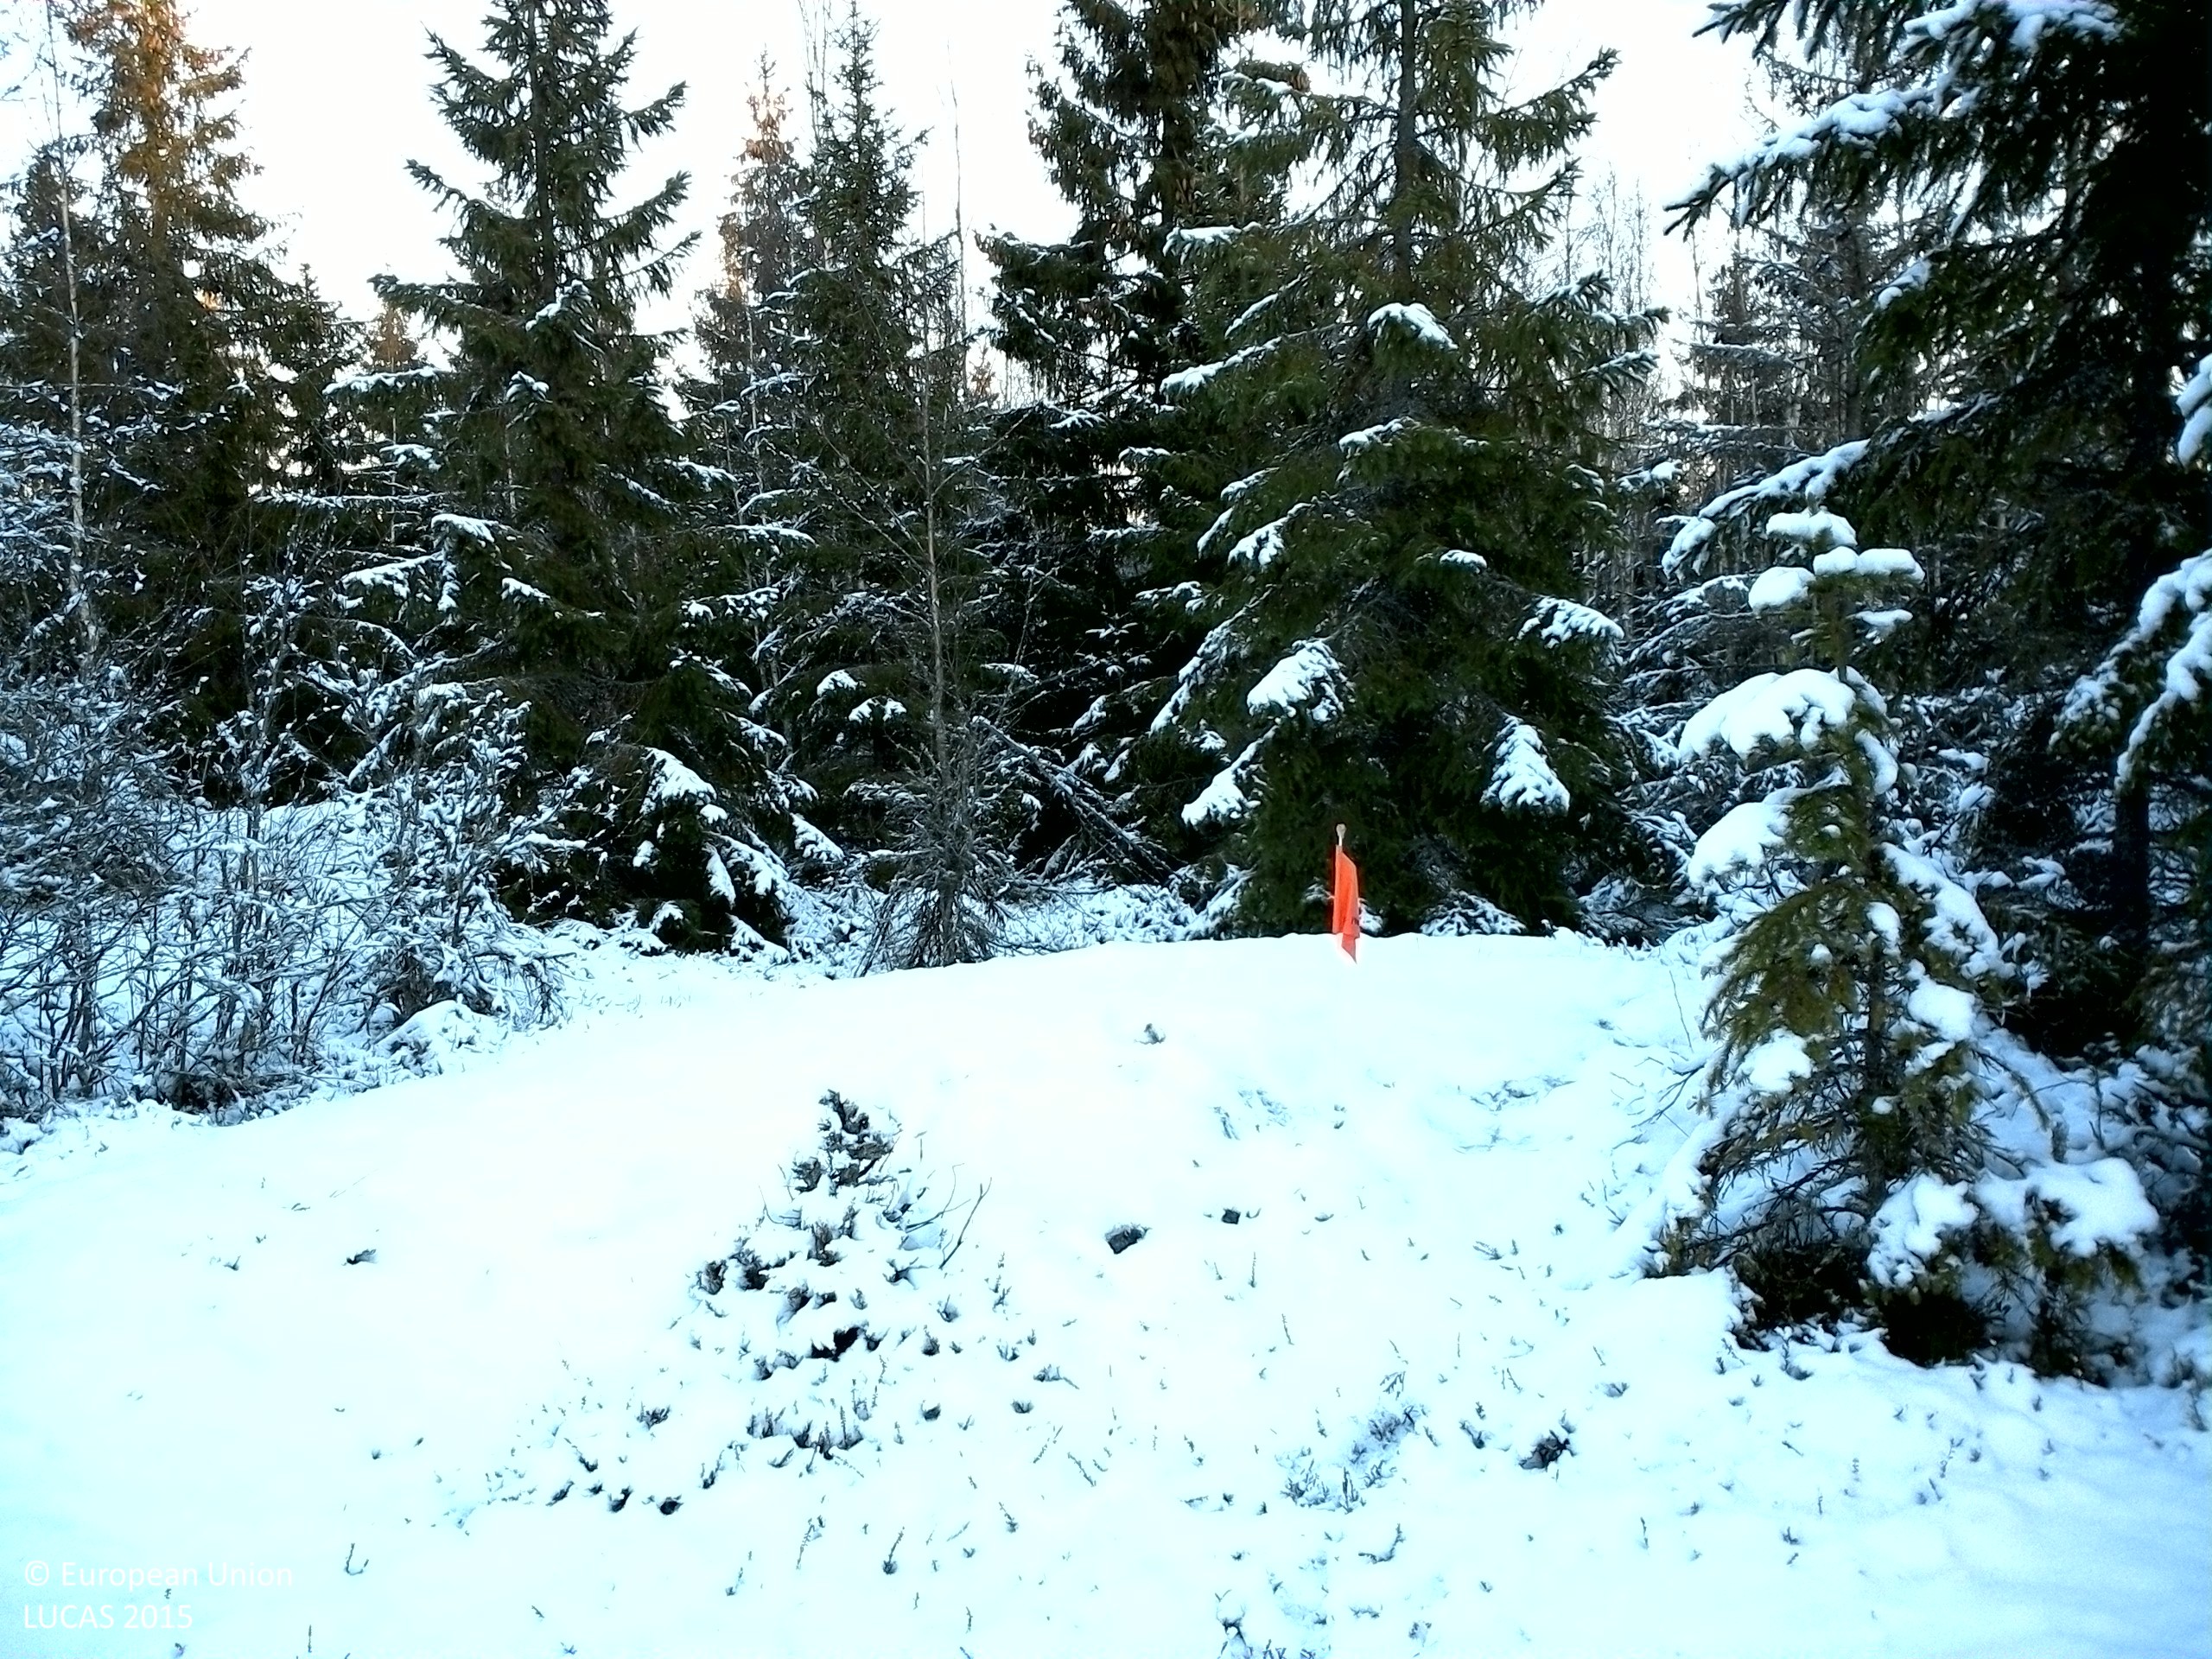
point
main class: Woodland
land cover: Spruce dominated mixed woodland
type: boreal forest
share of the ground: 50 - 75 %
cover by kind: coniferous forest trees 40 %, consolidated bare surface 20 %, broadleaved forest trees 15 %, shrubs 15 %, herbaceous plants 5 %, lichens and mosses 5 %
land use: Semi-natural and natural areas not in use
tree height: > 5 m
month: December
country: SE
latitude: 59.6414
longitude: 16.3243
